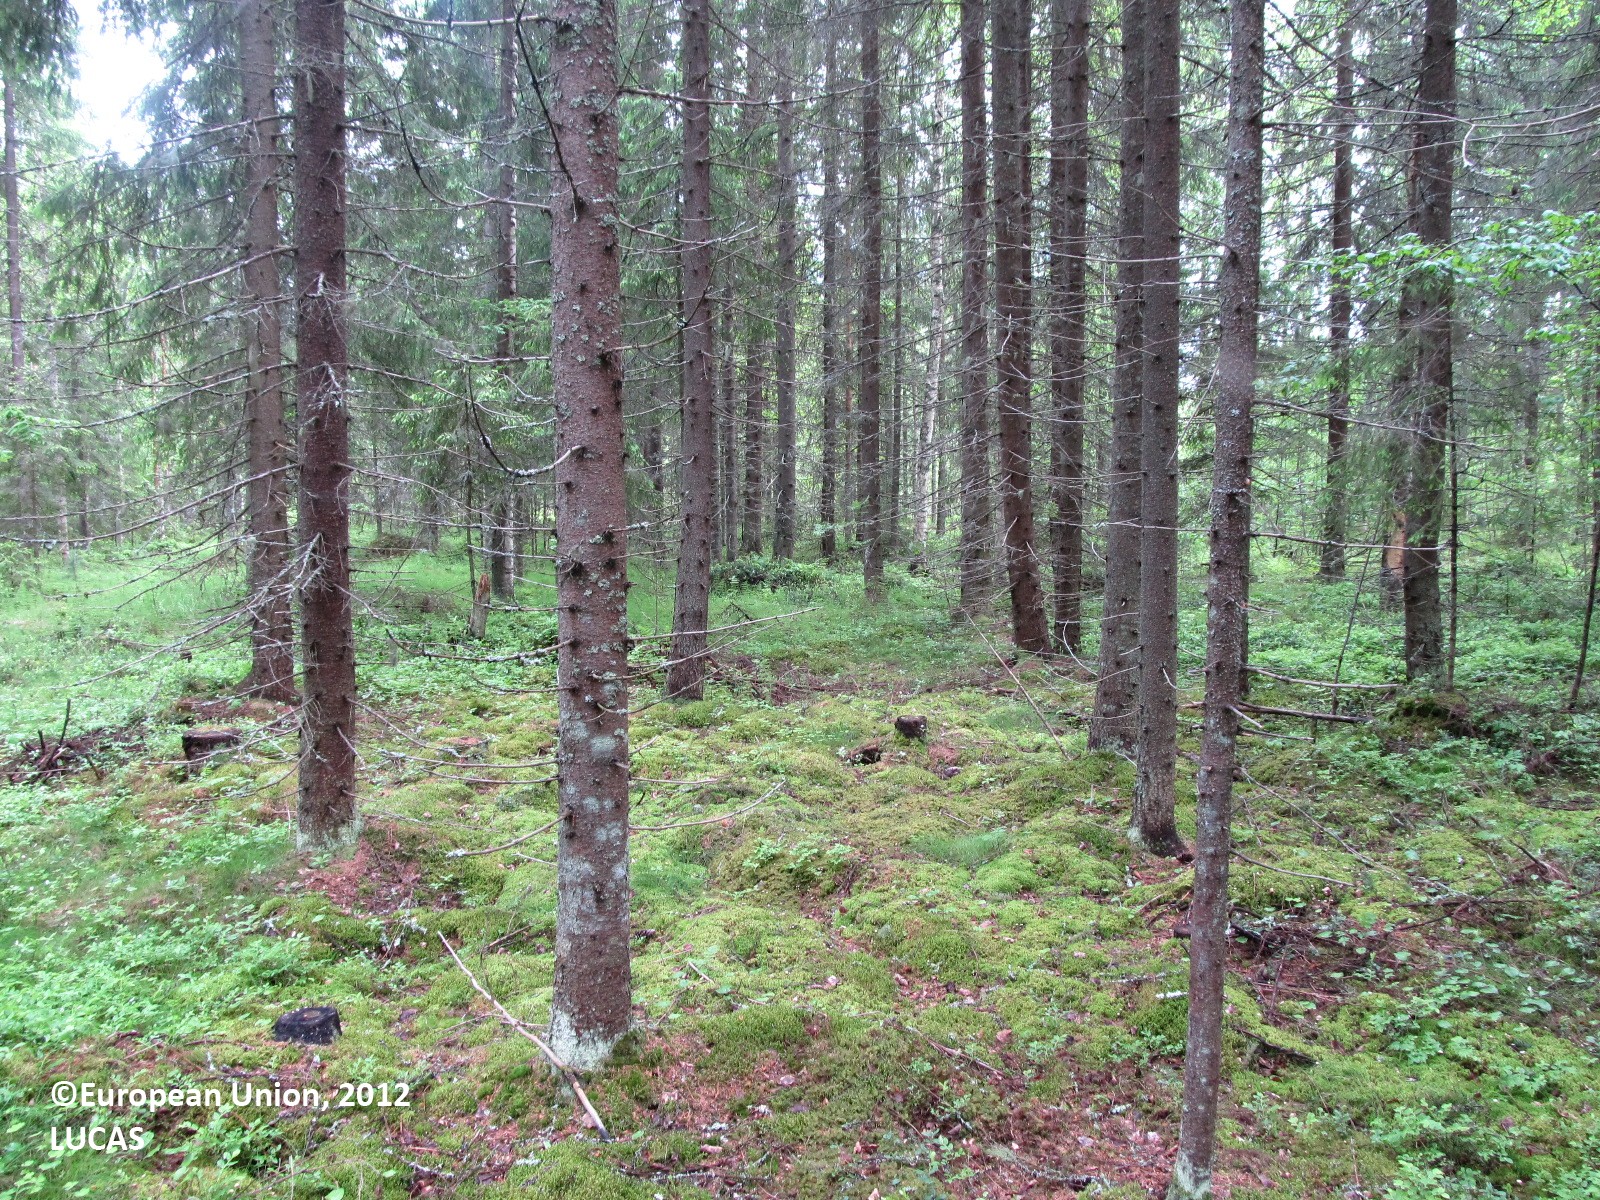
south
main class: Woodland
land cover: Spruce dominated coniferous woodland
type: boreal forest
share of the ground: 25 - 50 %
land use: Forestry
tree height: > 5 m
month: June
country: FI
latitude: 62.9249
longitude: 28.1643
